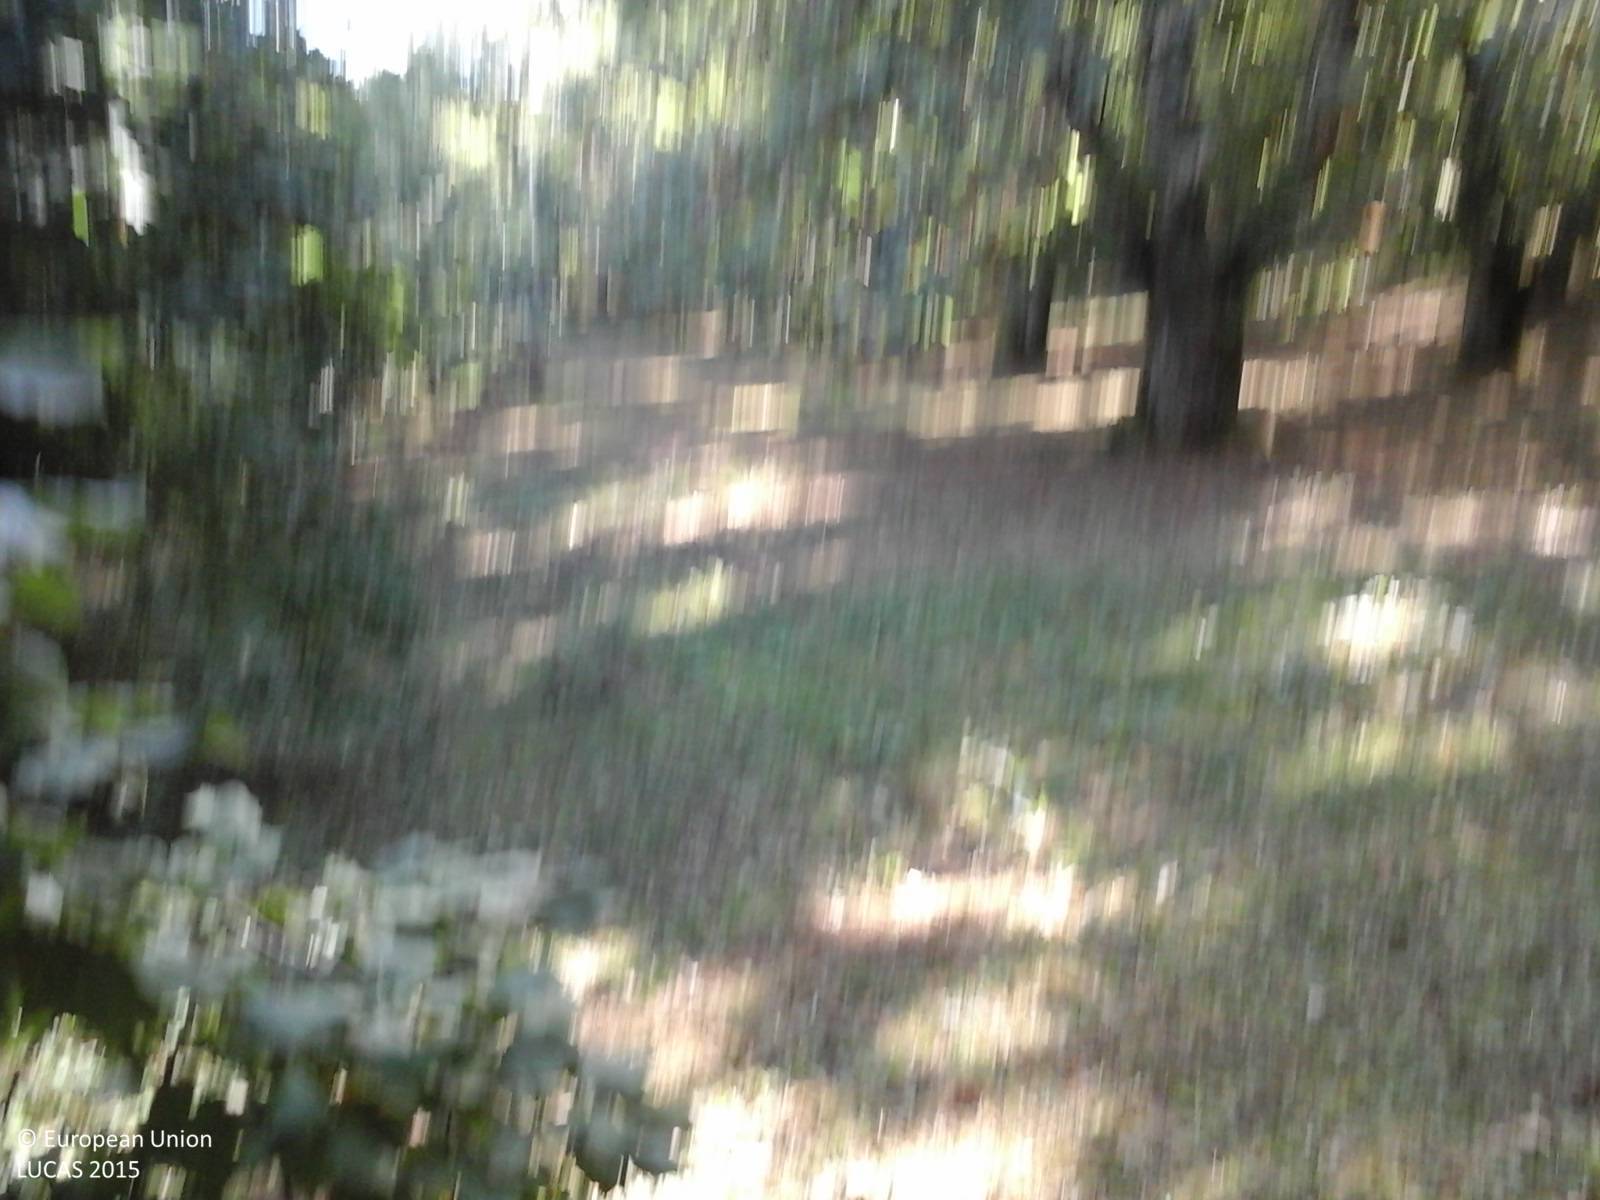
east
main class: Cropland
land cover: Nuts trees
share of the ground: > 75 %
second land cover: Grassland without tree/shrub cover
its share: 10 - 25 %
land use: Agriculture (excluding fallow land and kitchen gardens)
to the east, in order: Nuts trees; Grassland without tree/shrub cover; Electric lines; Nuts trees; Fences; Nuts trees; Fences; Nuts trees; Fences; Nuts trees
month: September
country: IT
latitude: 42.3763
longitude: 12.2391
